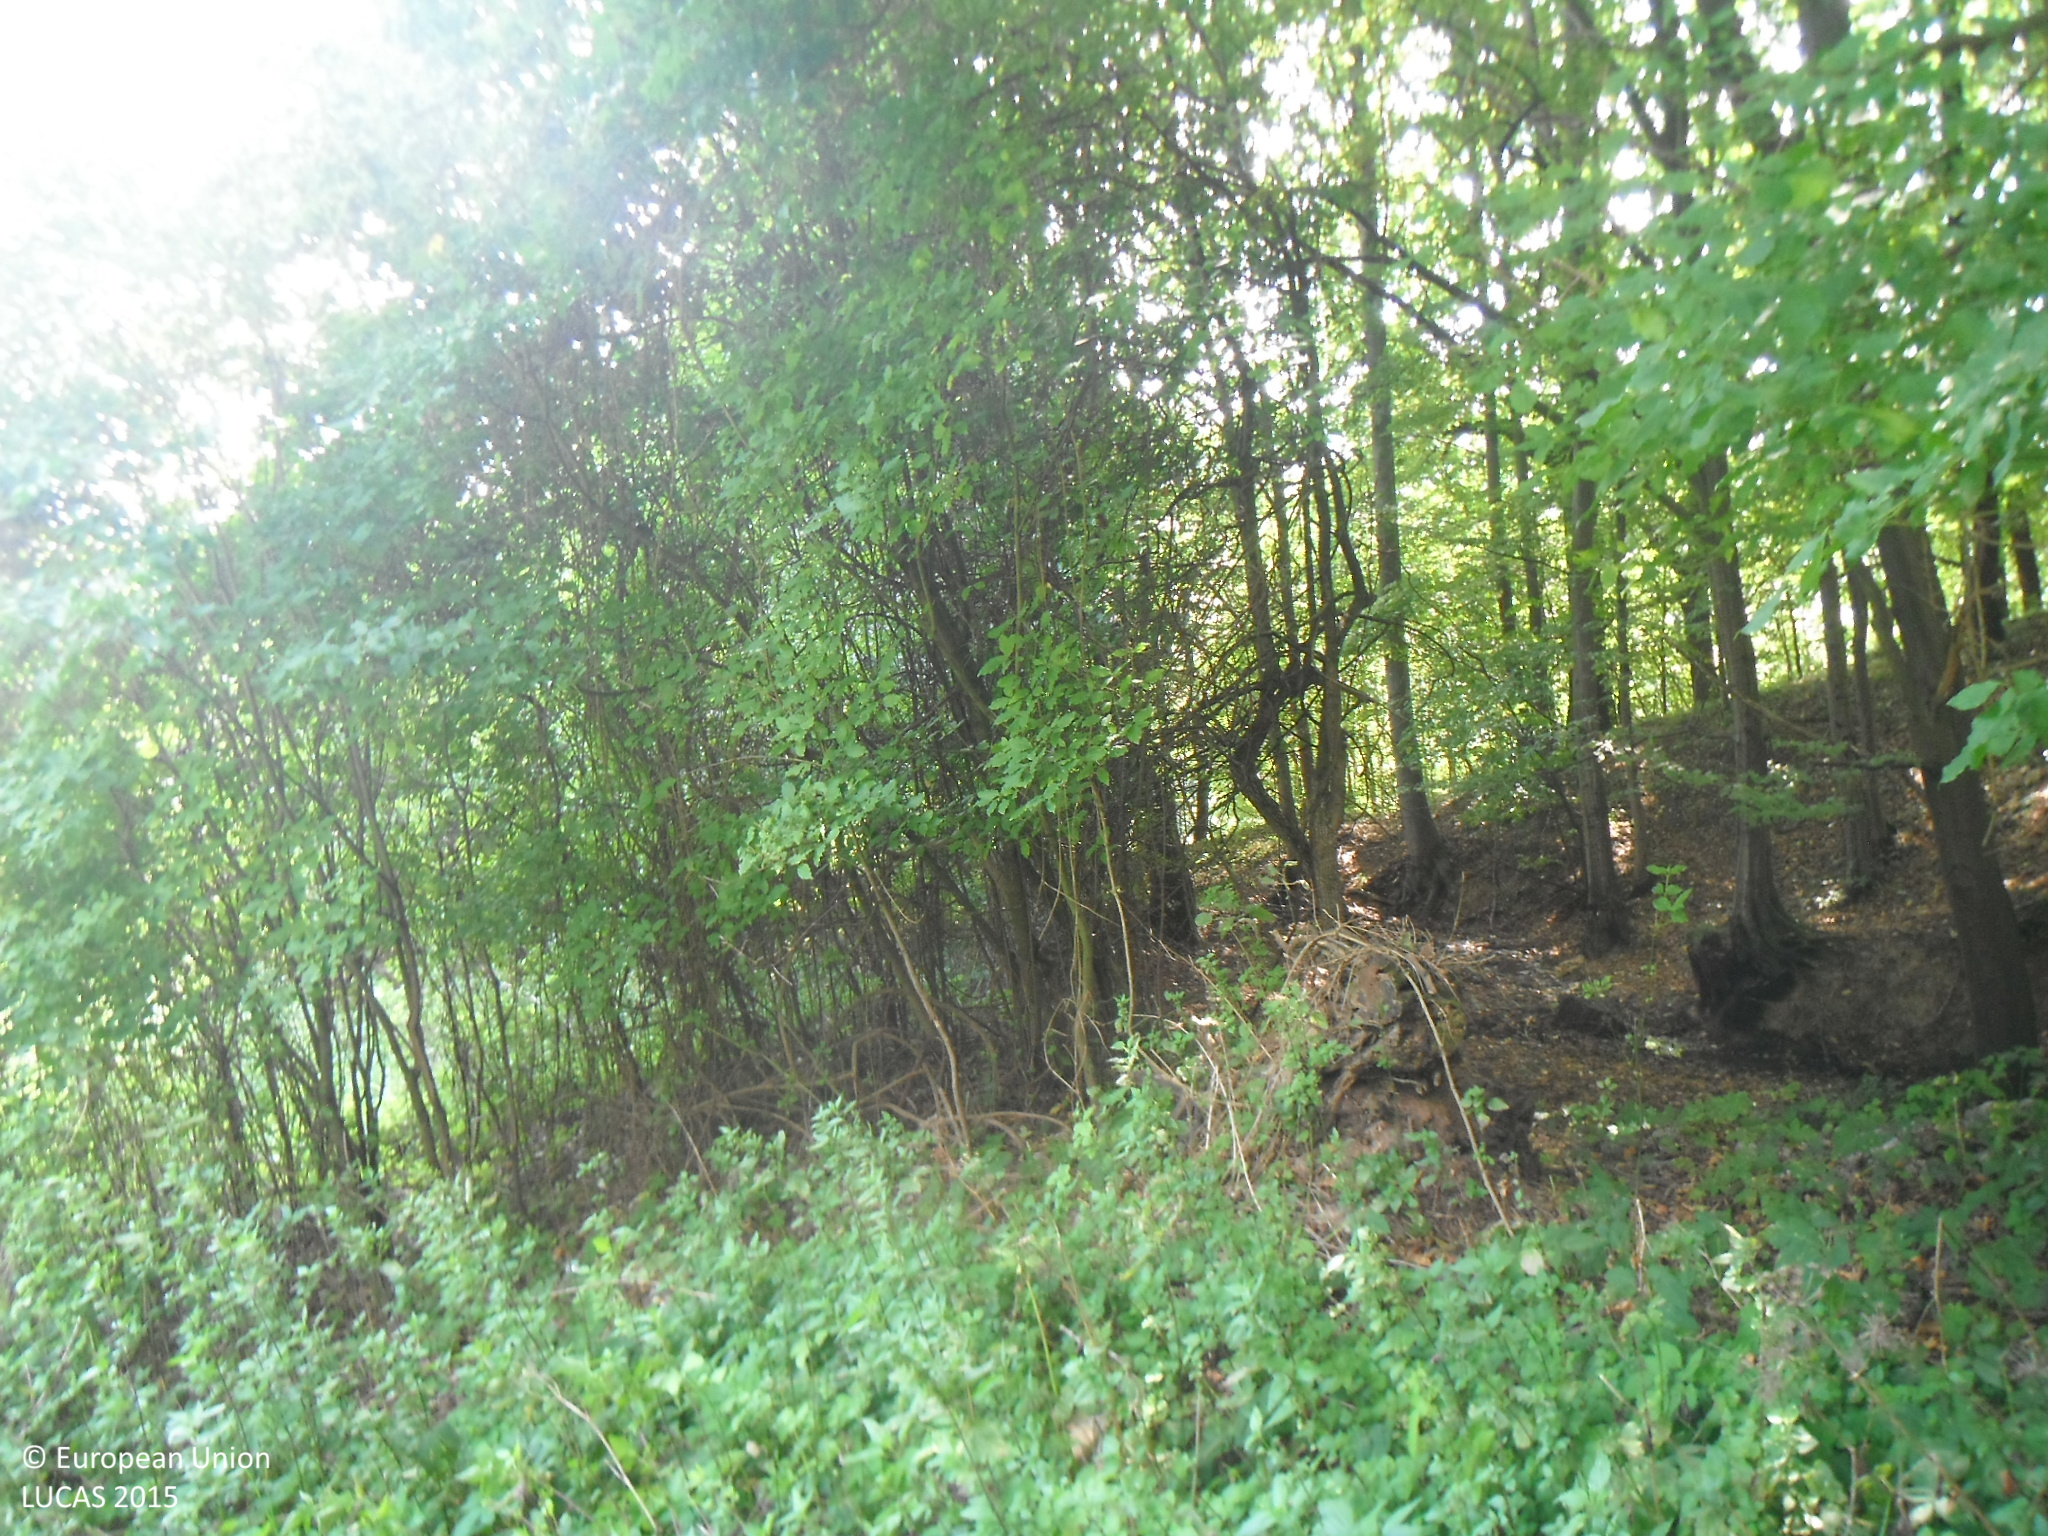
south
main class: Woodland
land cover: Broadleaved woodland
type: mesophytic deciduous forest
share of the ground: > 75 %
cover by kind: broadleaved forest trees 100 %
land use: Forestry
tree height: > 5 m
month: September
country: SK
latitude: 48.7464
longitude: 17.4772
